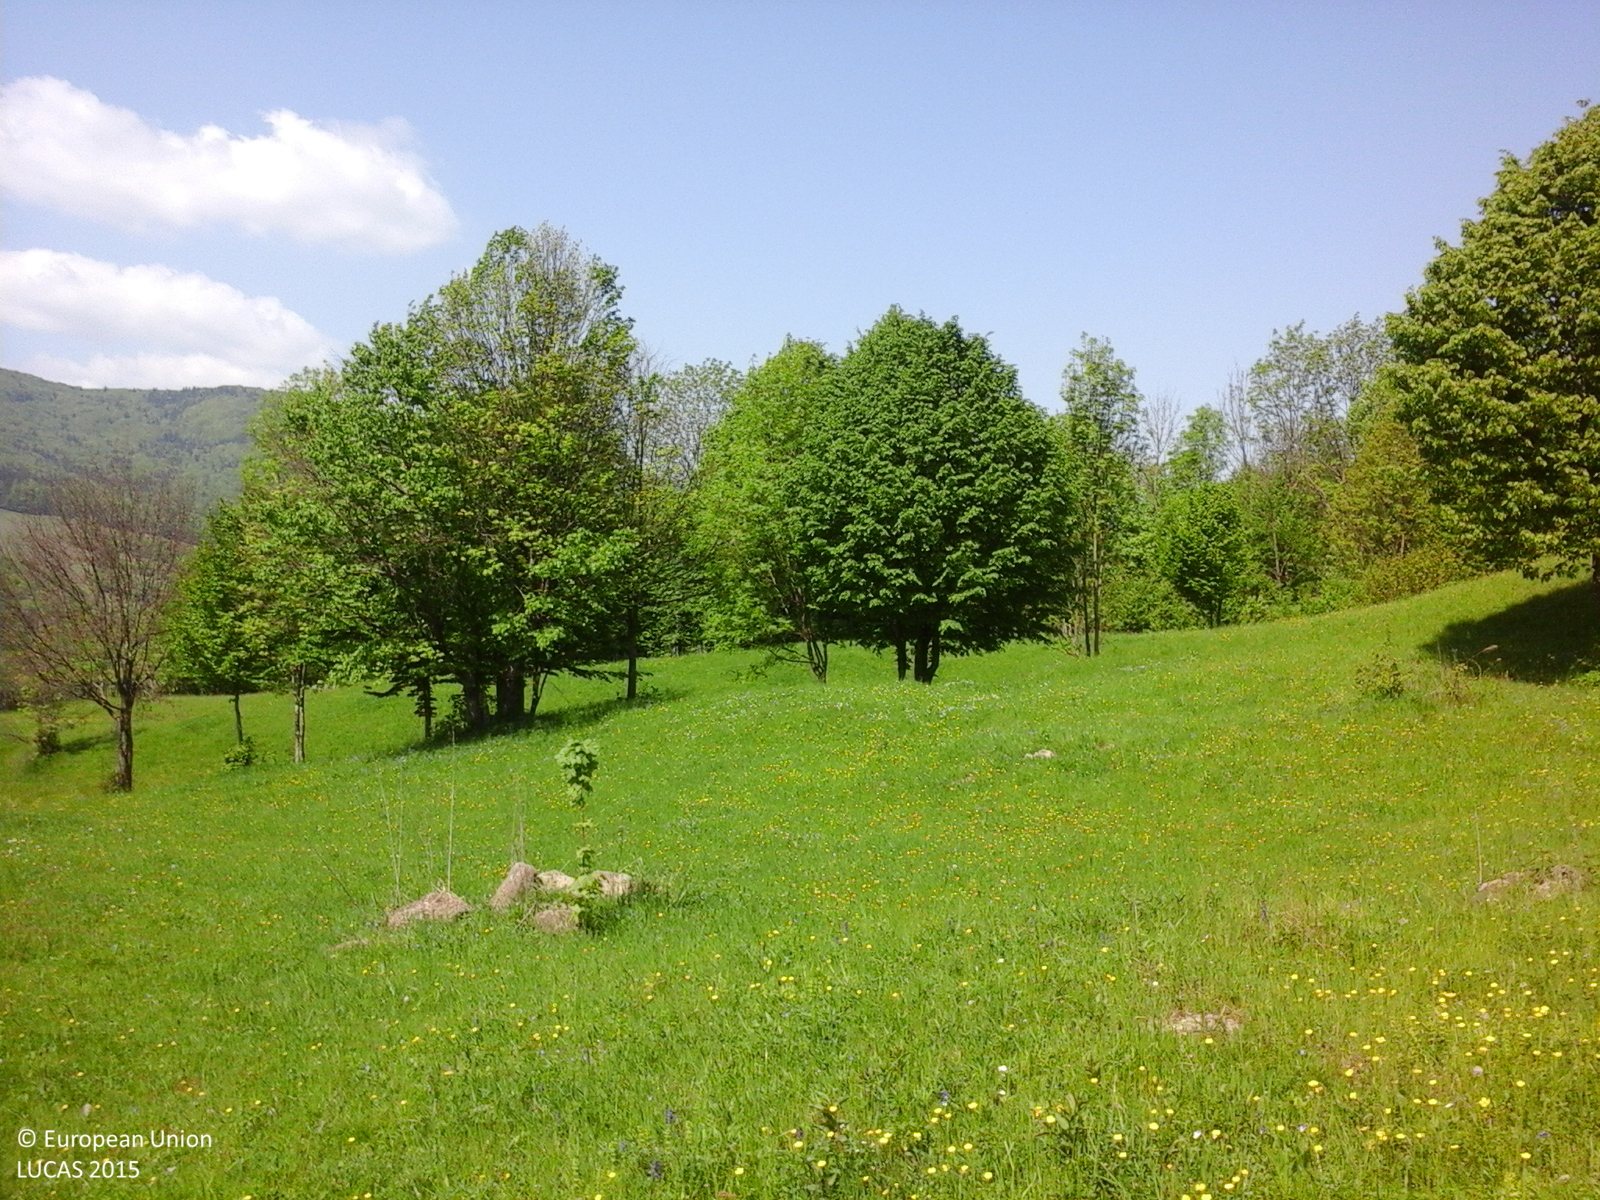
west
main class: Grassland
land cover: Grassland without tree/shrub cover
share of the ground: > 75 %
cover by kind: herbaceous plants 100 %
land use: Agriculture (excluding fallow land and kitchen gardens)
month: May
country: RO
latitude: 45.5904
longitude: 26.1529
